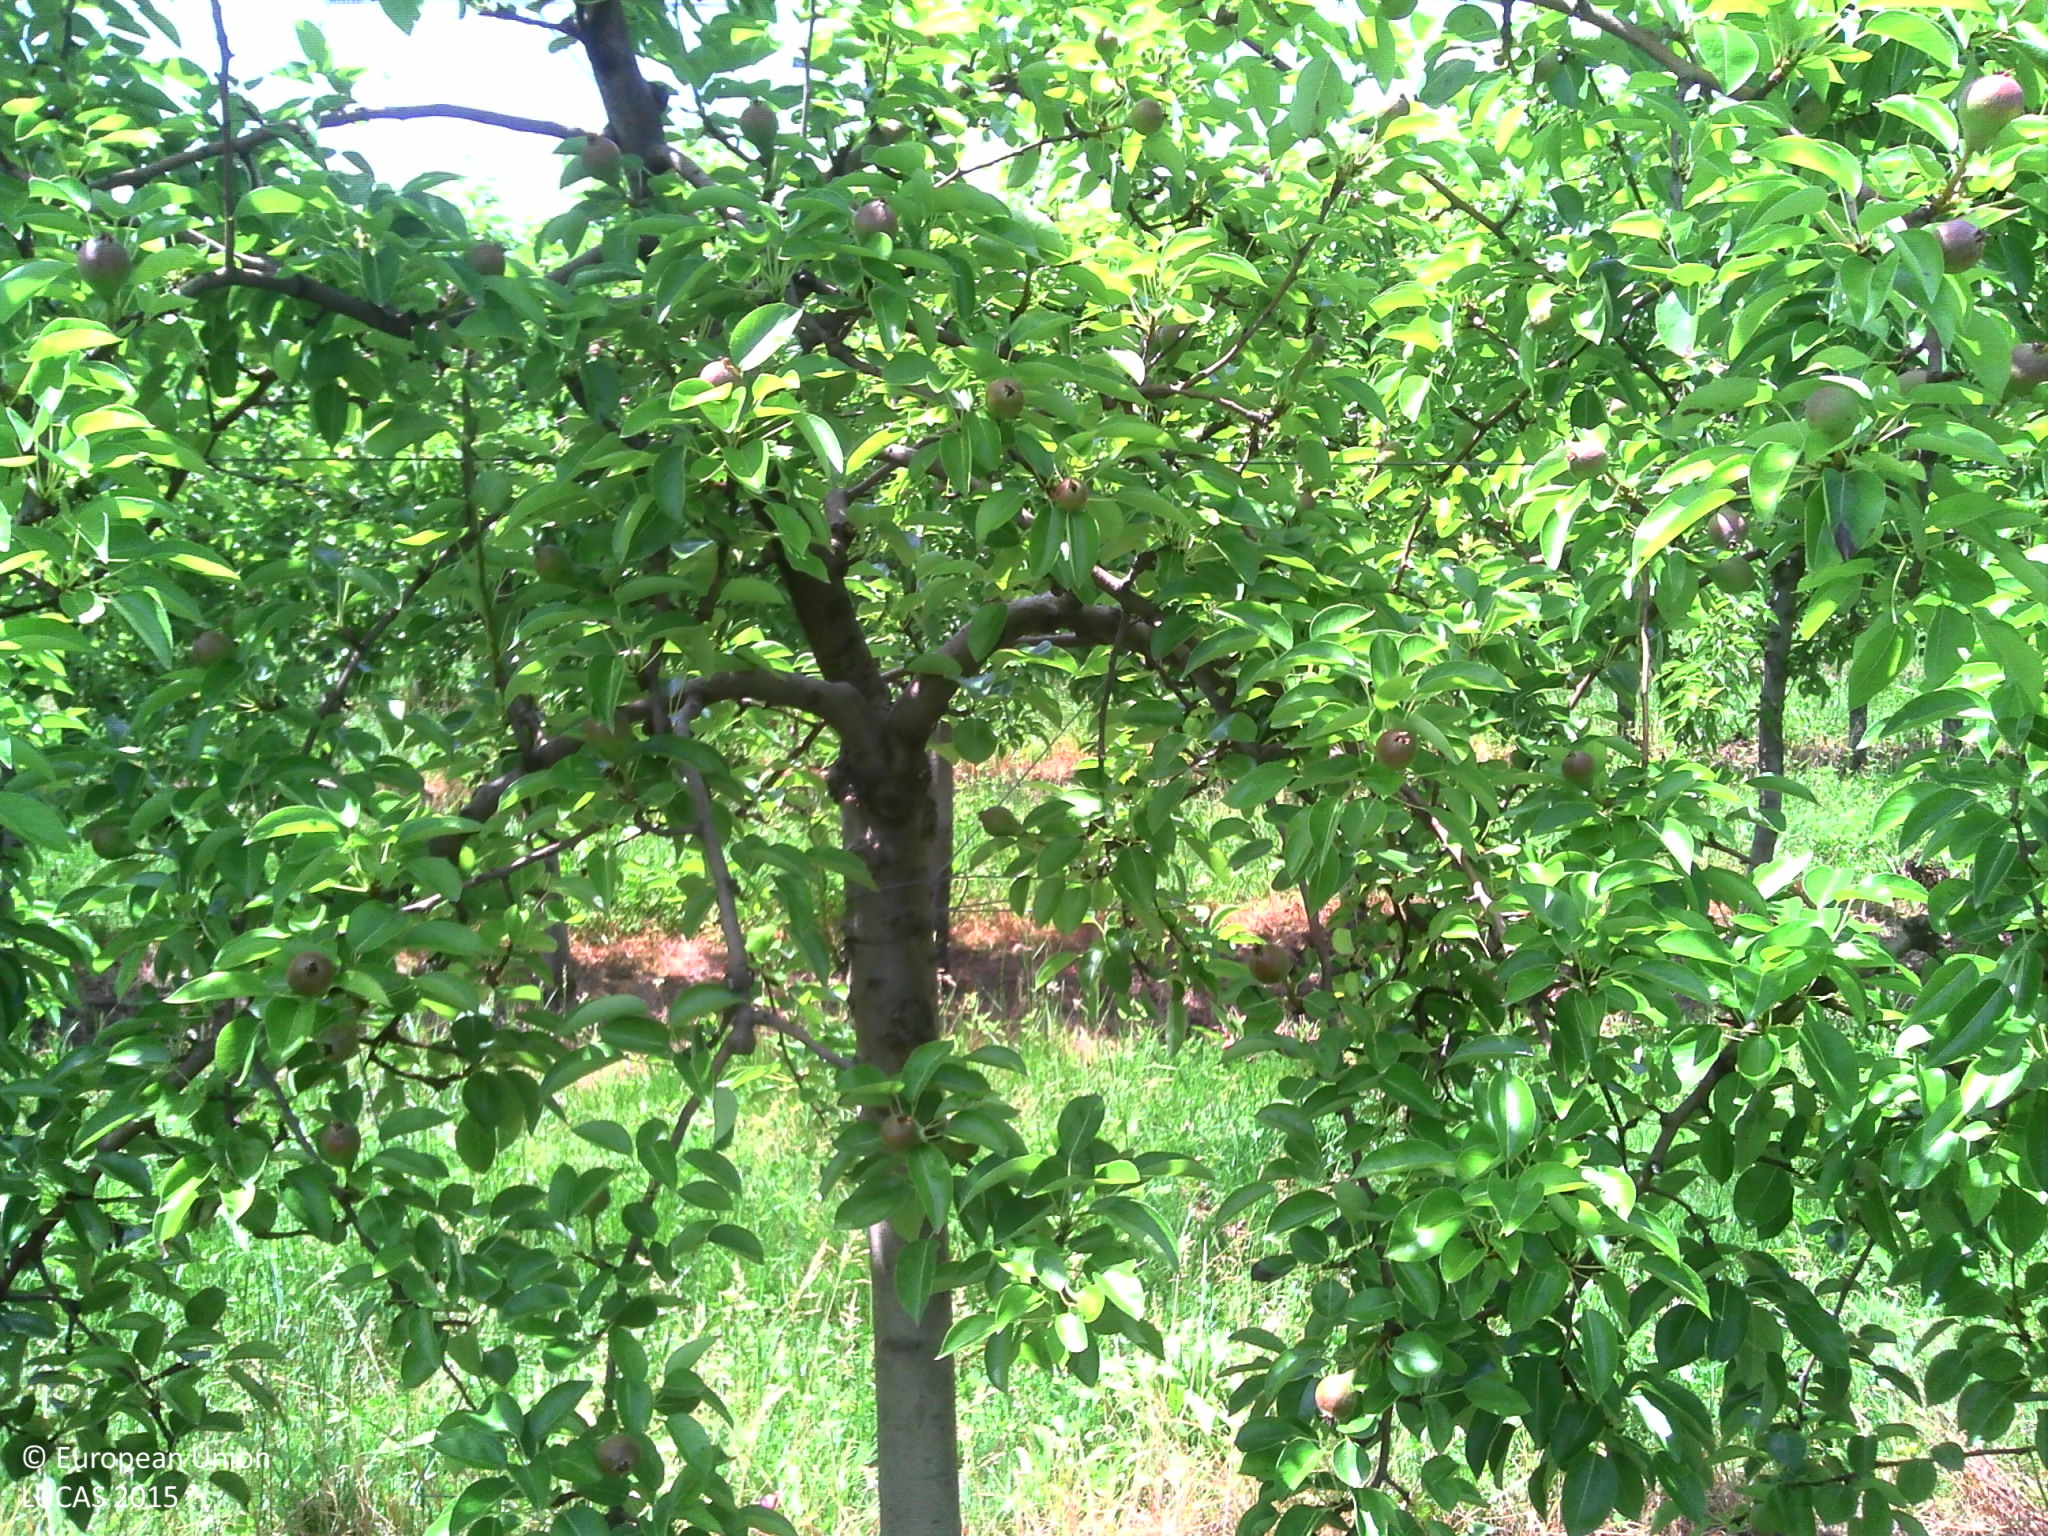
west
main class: Cropland
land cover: Pear fruit
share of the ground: 50 - 75 %
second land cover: Grassland without tree/shrub cover
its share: 50 - 75 %
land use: Agriculture (excluding fallow land and kitchen gardens)
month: June
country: FR
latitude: 46.4802
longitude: 4.8569
